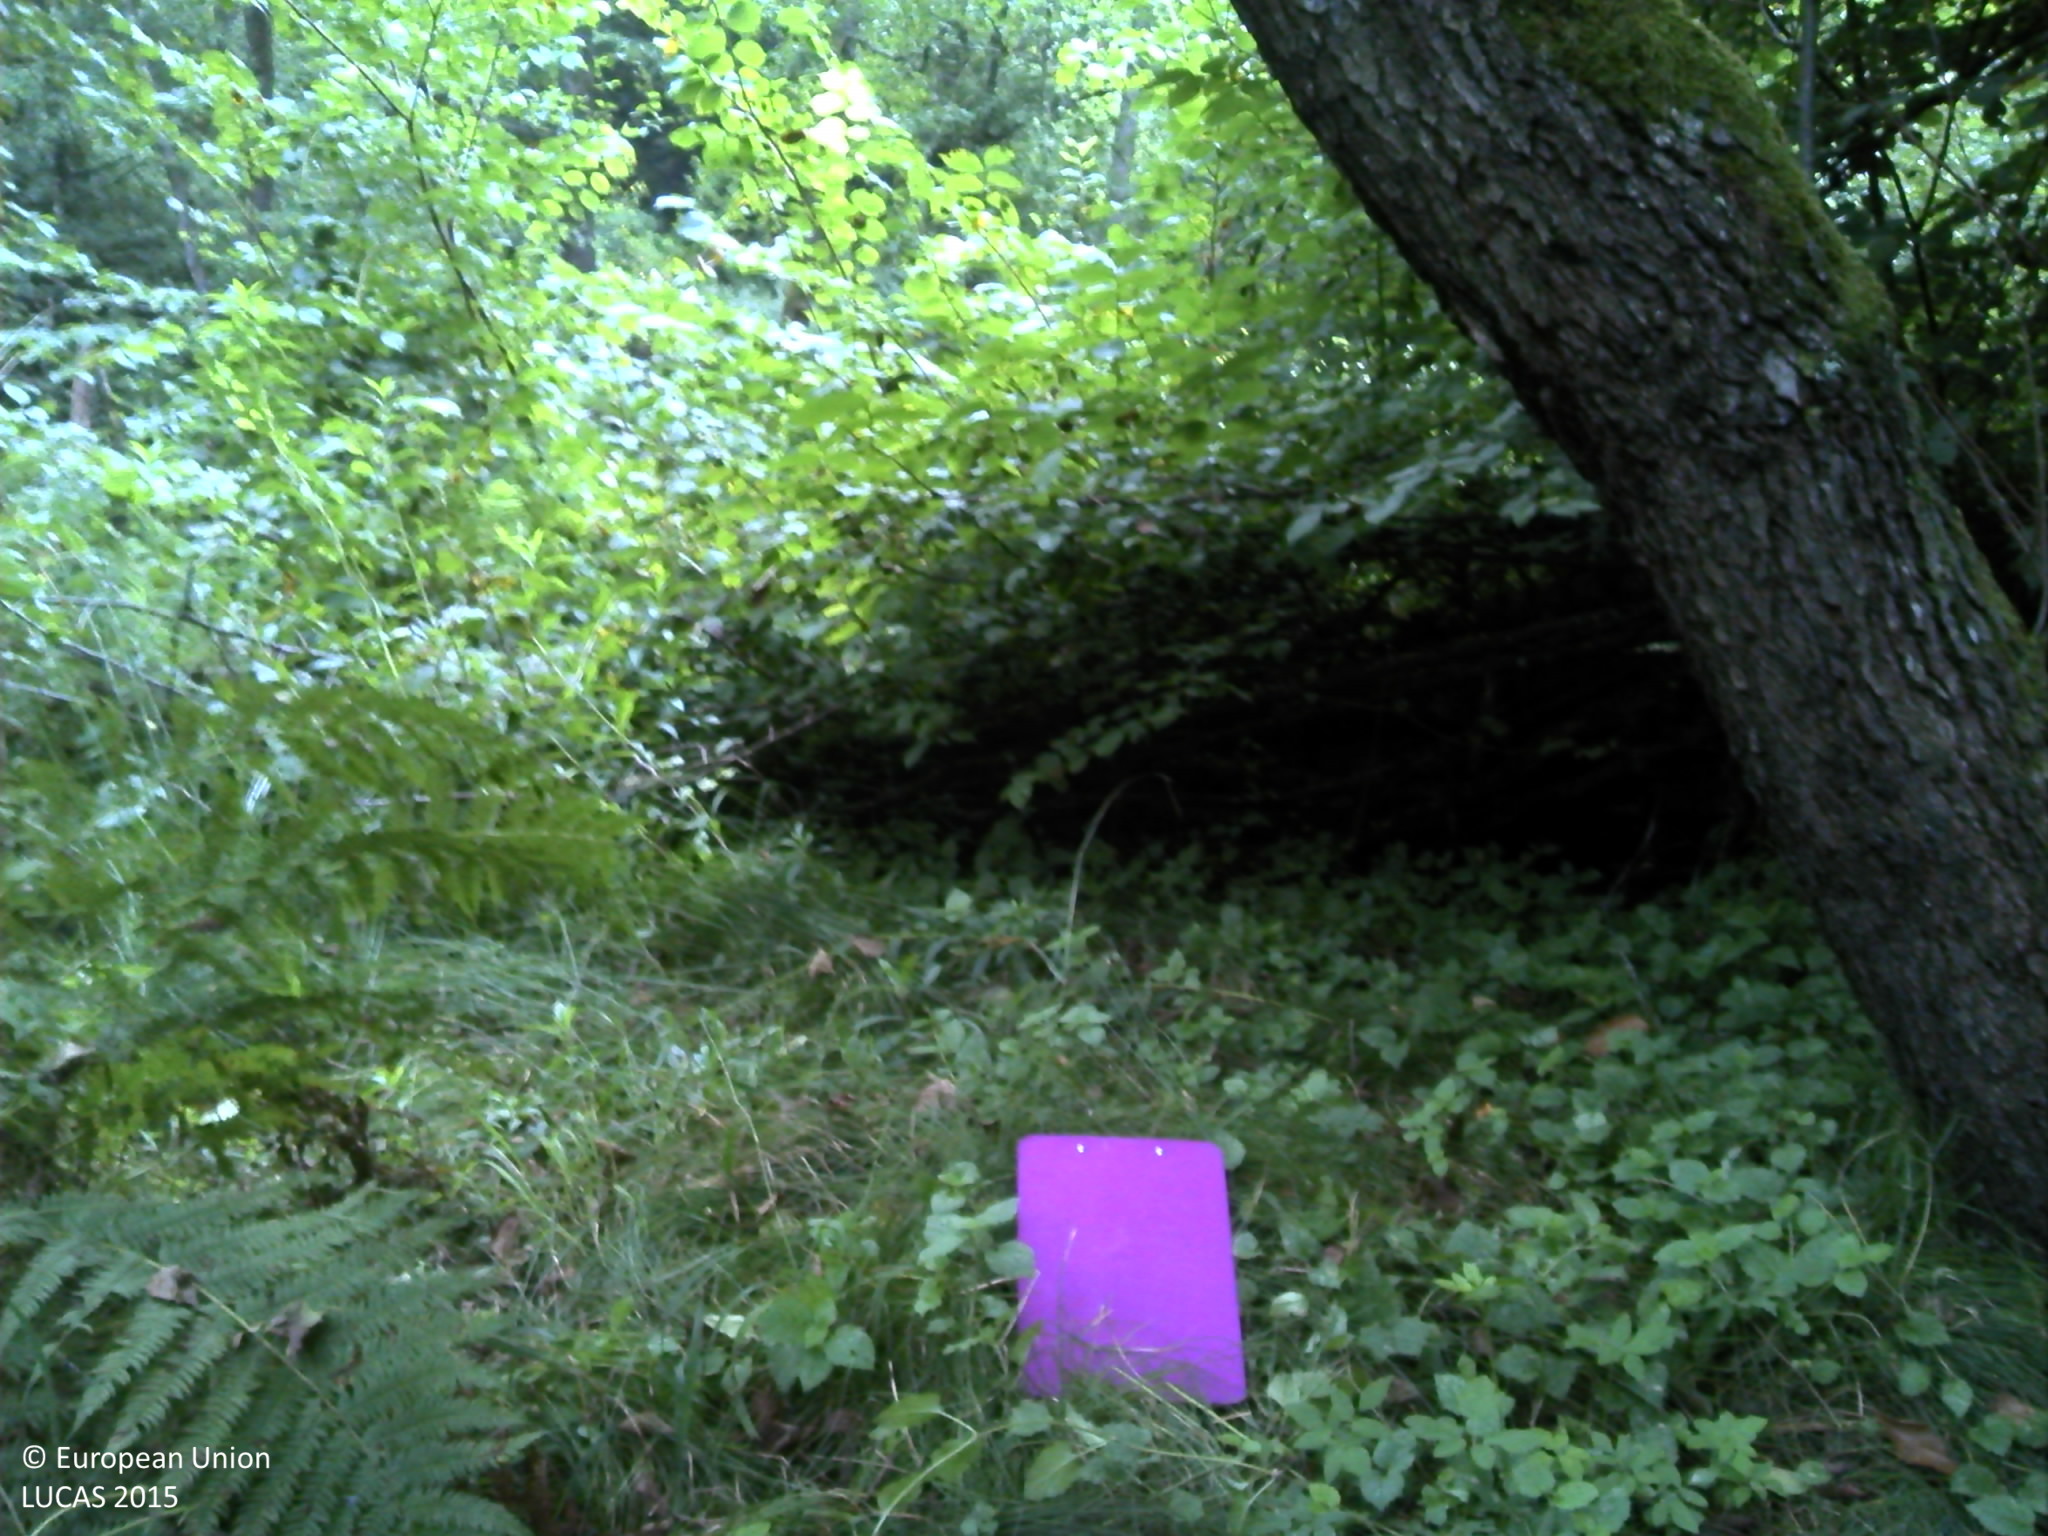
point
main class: Woodland
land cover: Broadleaved woodland
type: acidophilous oak and oak-birch forest
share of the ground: > 75 %
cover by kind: broadleaved forest trees 100 %
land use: Forestry
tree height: > 5 m
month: August
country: HR
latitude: 45.3212
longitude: 15.9030
